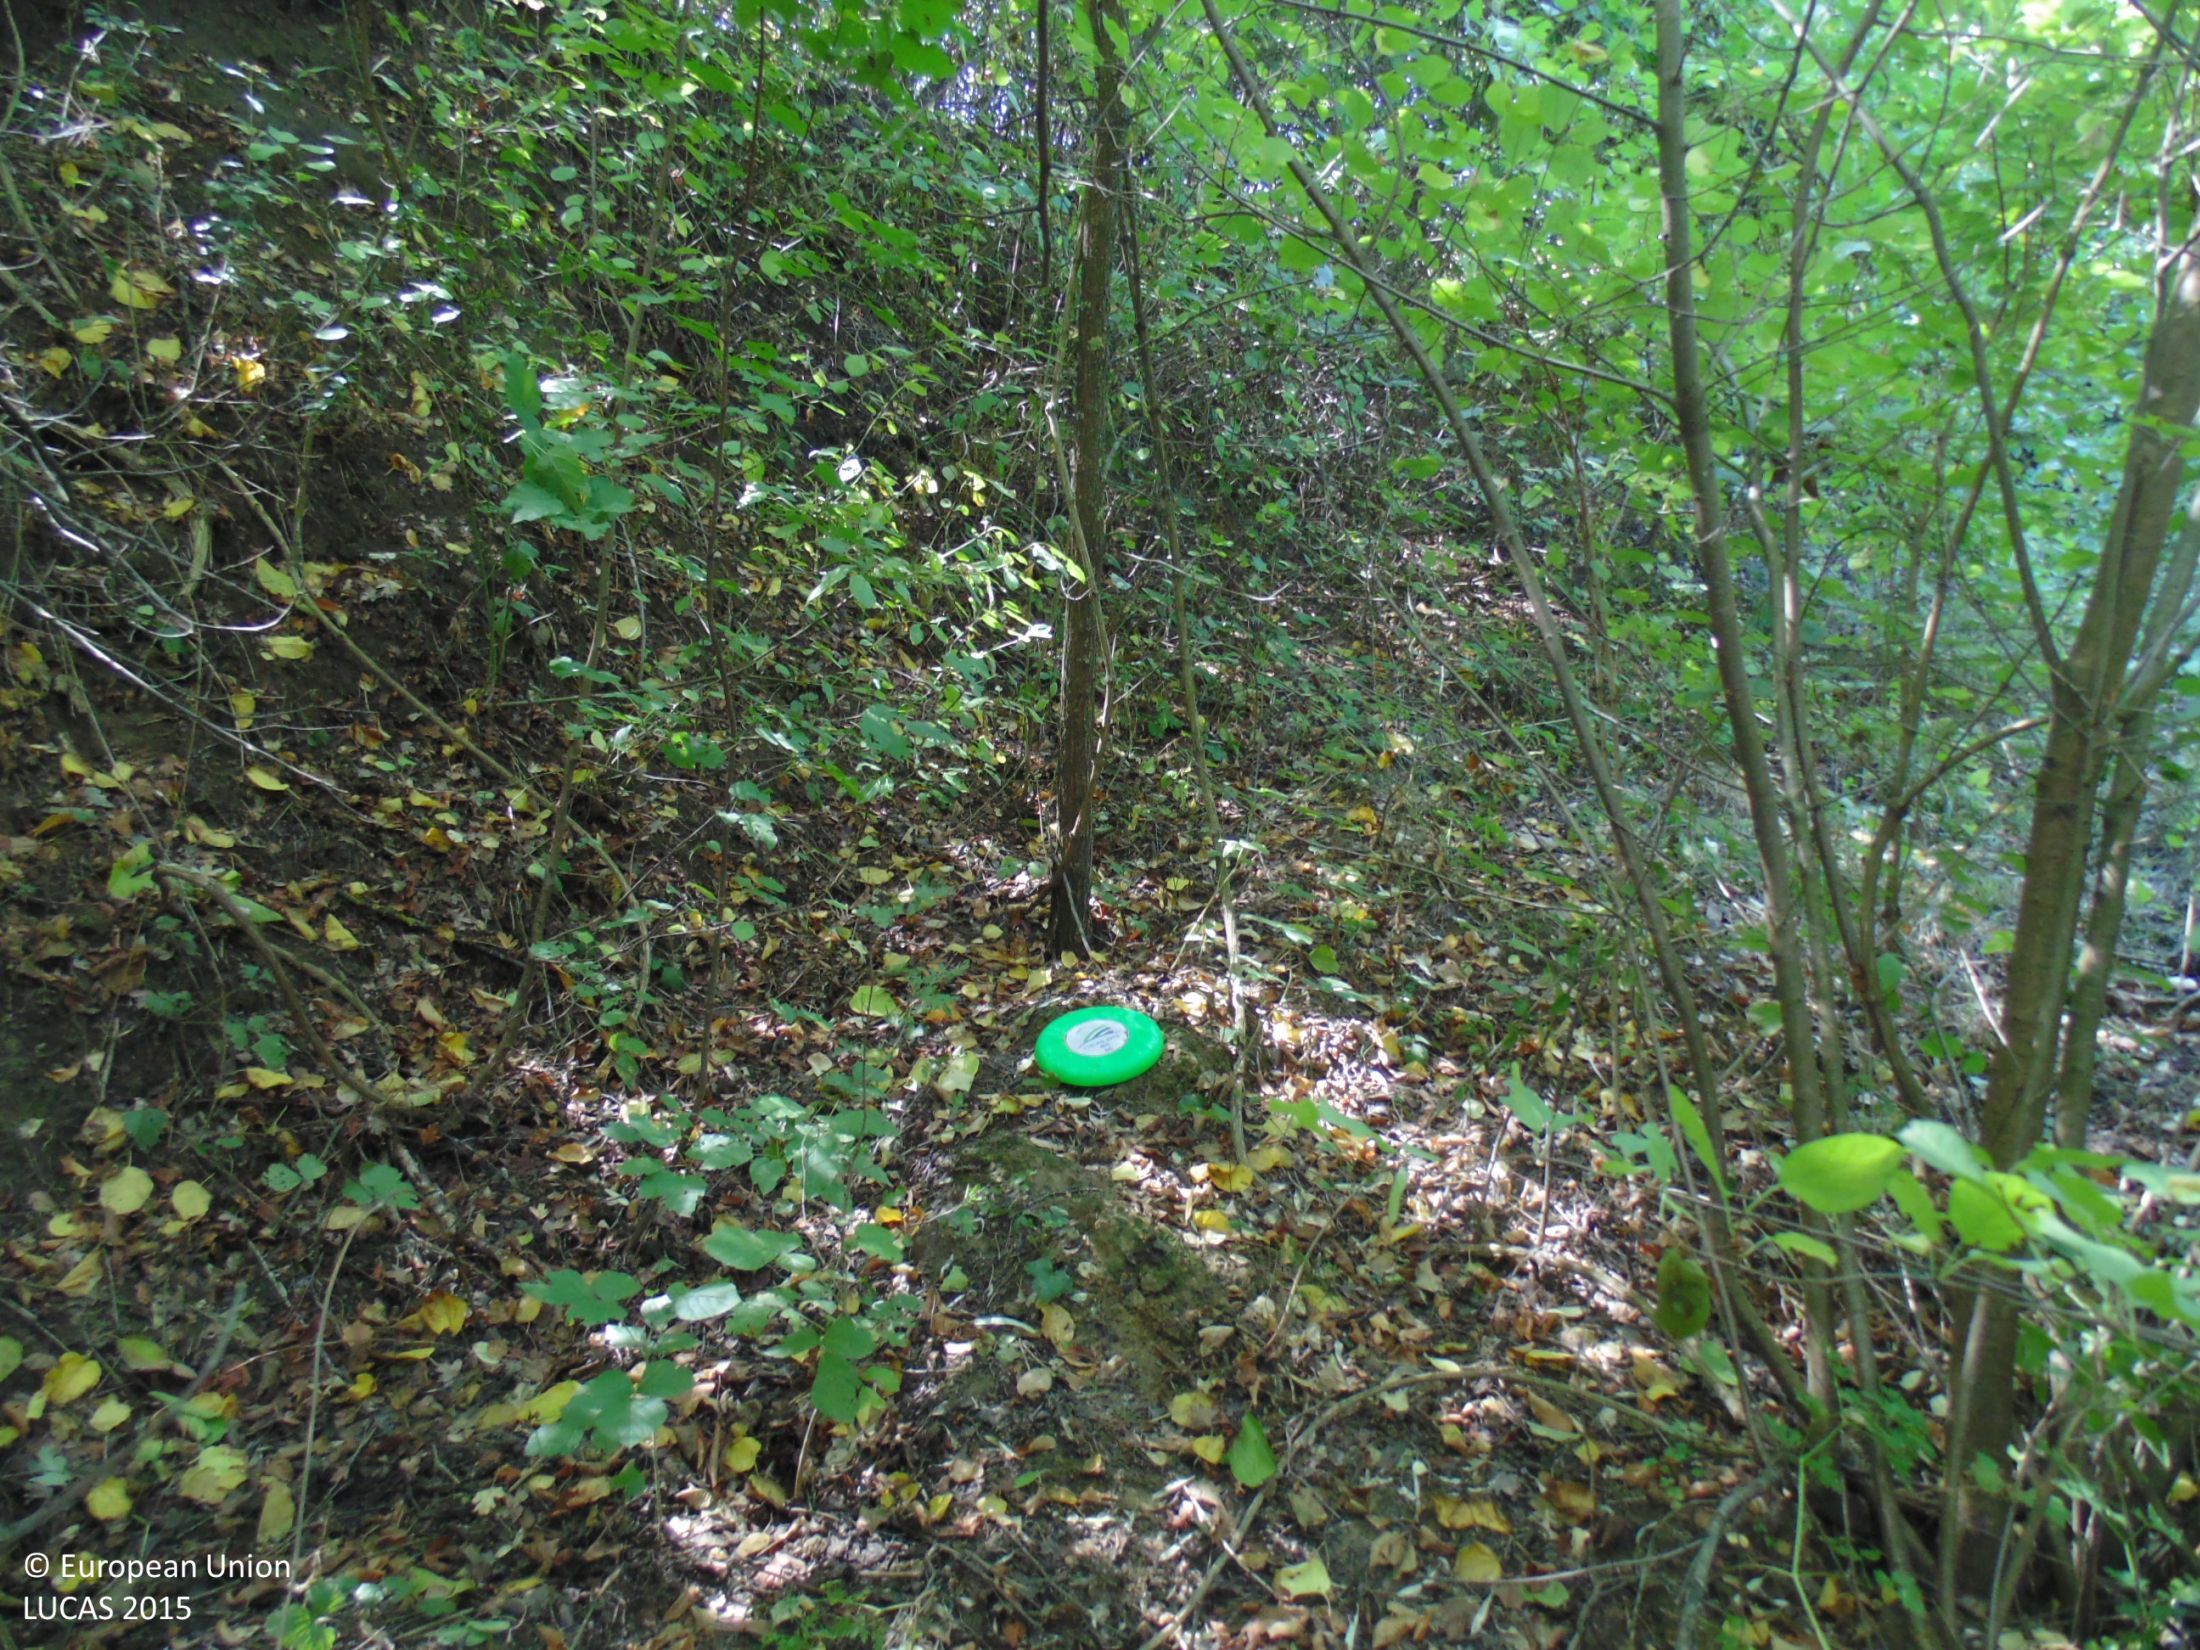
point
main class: Woodland
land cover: Broadleaved woodland
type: mesophytic deciduous forest
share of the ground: > 75 %
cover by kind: broadleaved forest trees 90 %, shrubs 5 %, unconsolidated bare surface 5 %
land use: Forestry
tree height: > 5 m
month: September
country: BG
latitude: 44.1162
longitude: 26.9802
